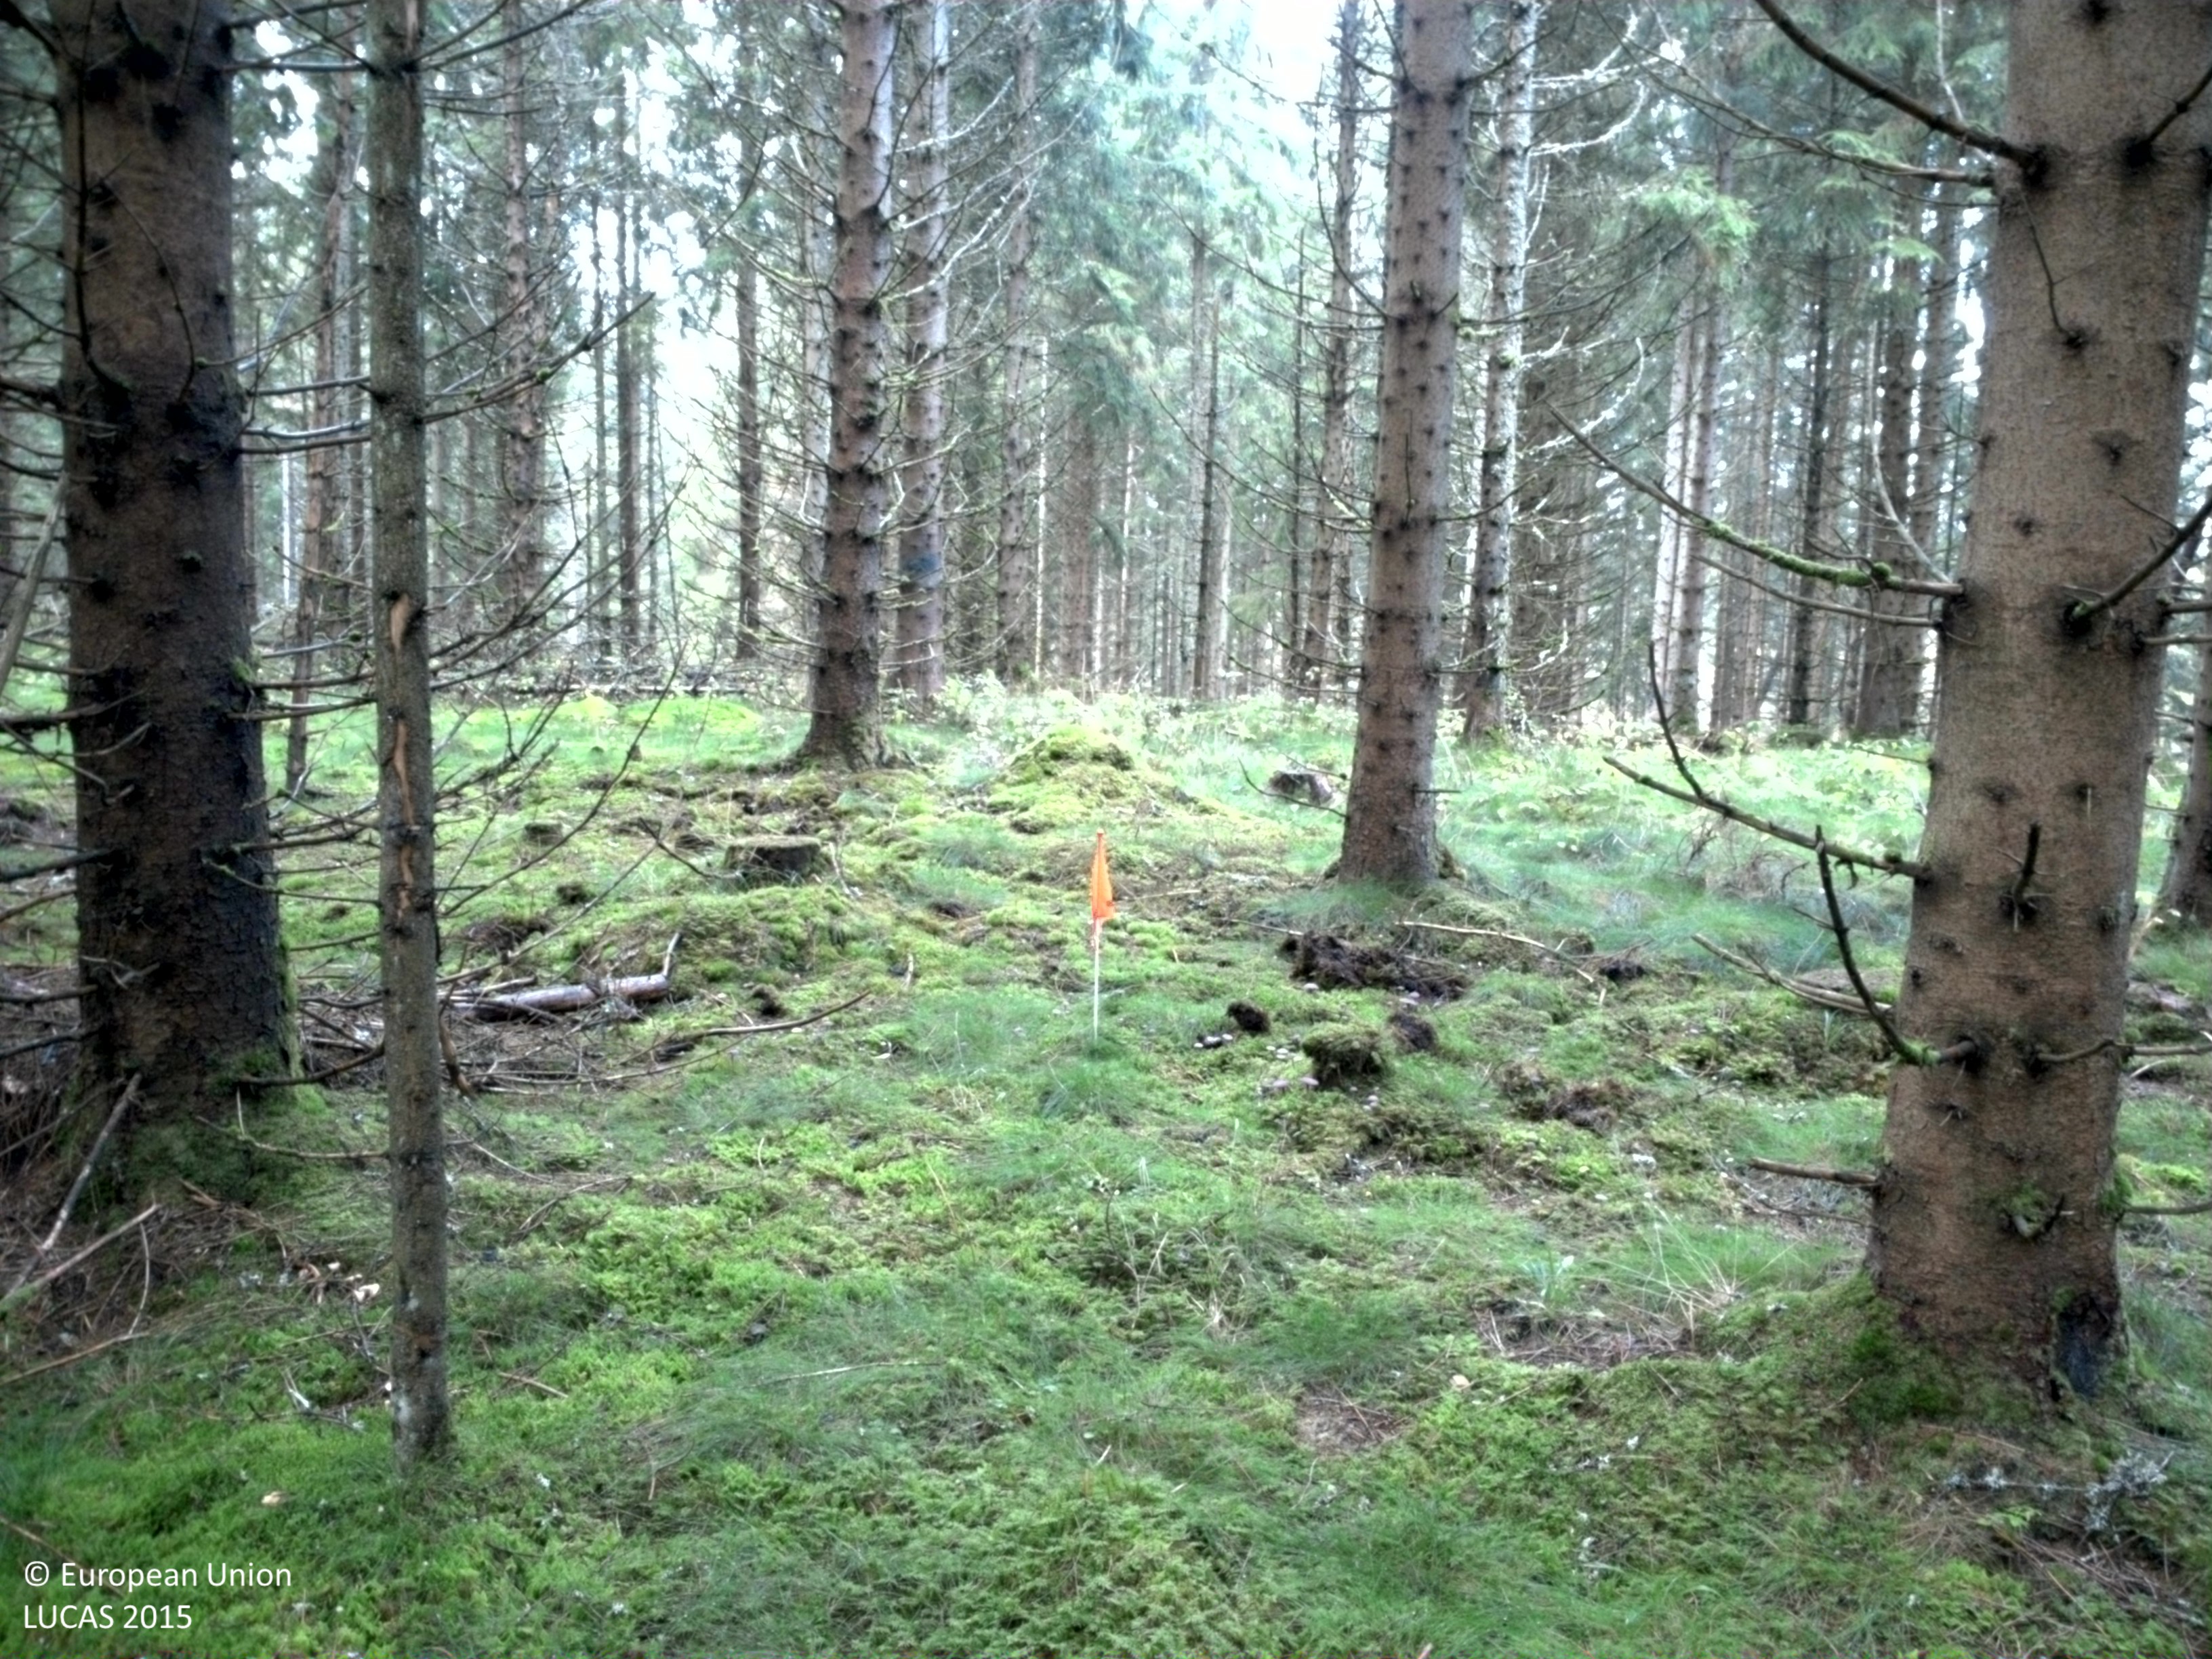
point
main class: Woodland
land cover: Spruce dominated coniferous woodland
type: boreal forest
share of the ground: 50 - 75 %
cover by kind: coniferous forest trees 60 %, lichens and mosses 30 %, herbaceous plants 10 %
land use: Forestry
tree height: > 5 m
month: September
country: SE
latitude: 58.1289
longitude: 13.1362
